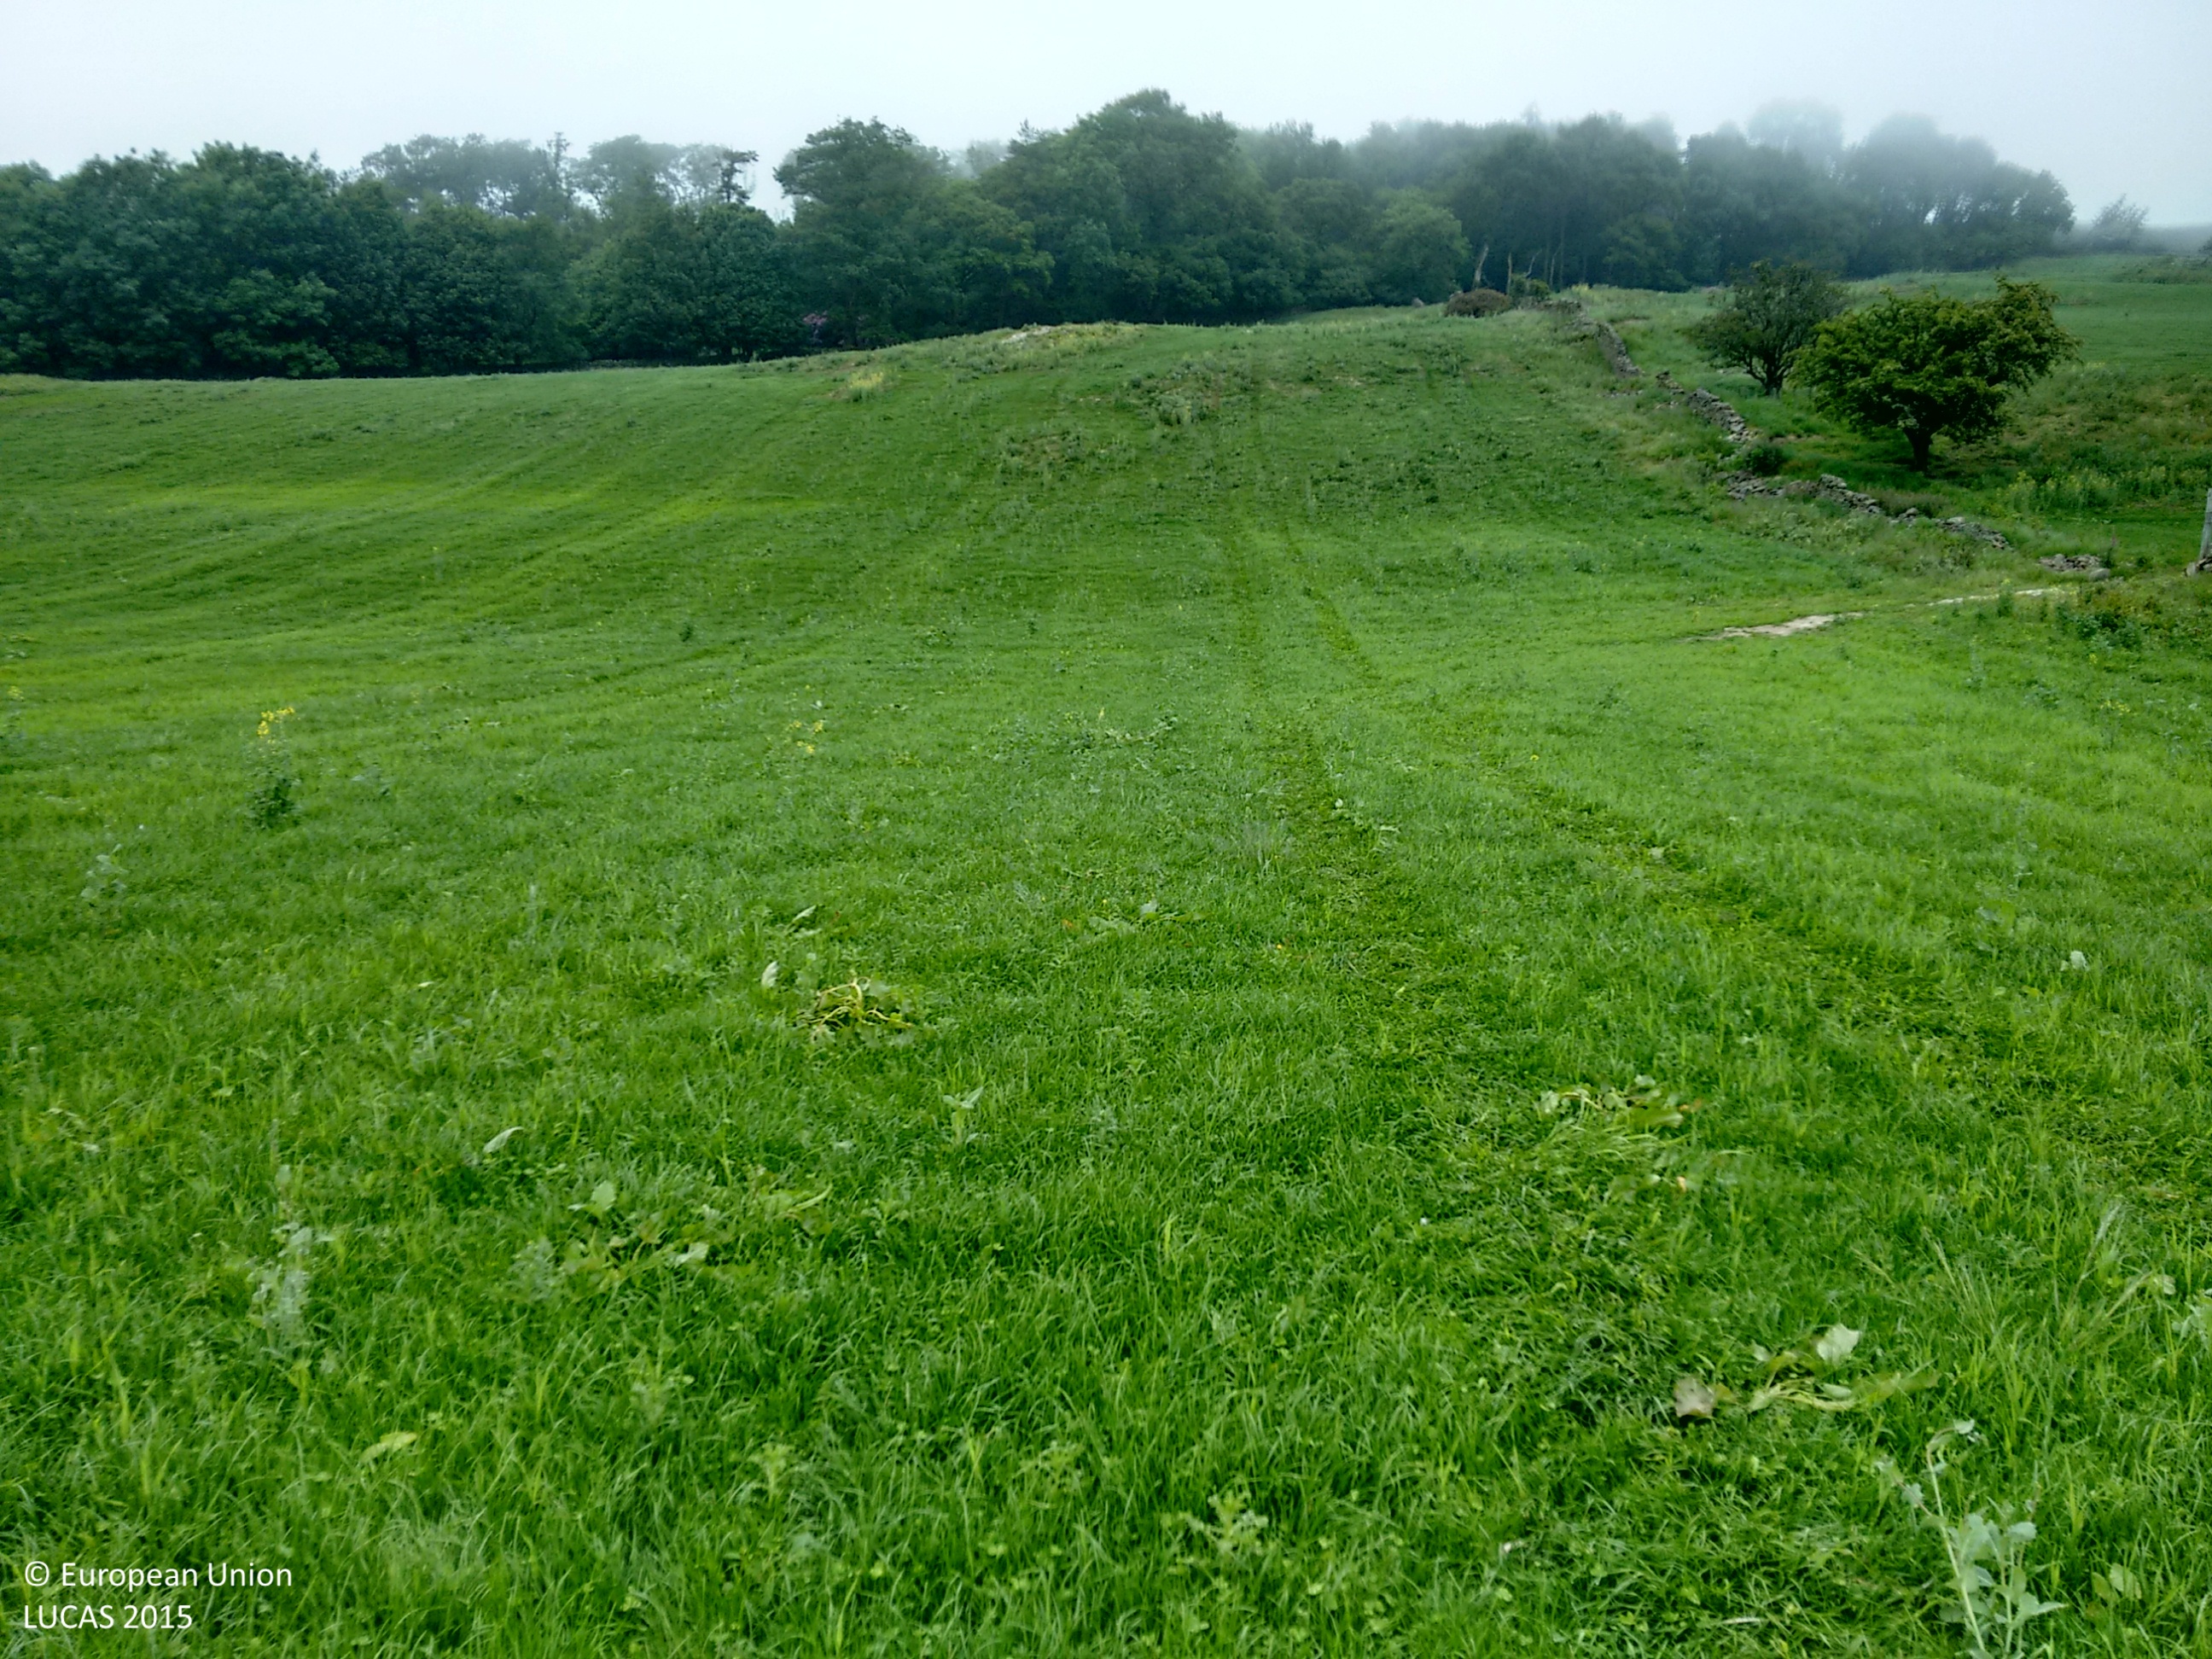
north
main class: Grassland
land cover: Grassland without tree/shrub cover
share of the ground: > 75 %
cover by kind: herbaceous plants 100 %
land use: Agriculture (excluding fallow land and kitchen gardens)
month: June
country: GB
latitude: 55.0798
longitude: -3.7284
